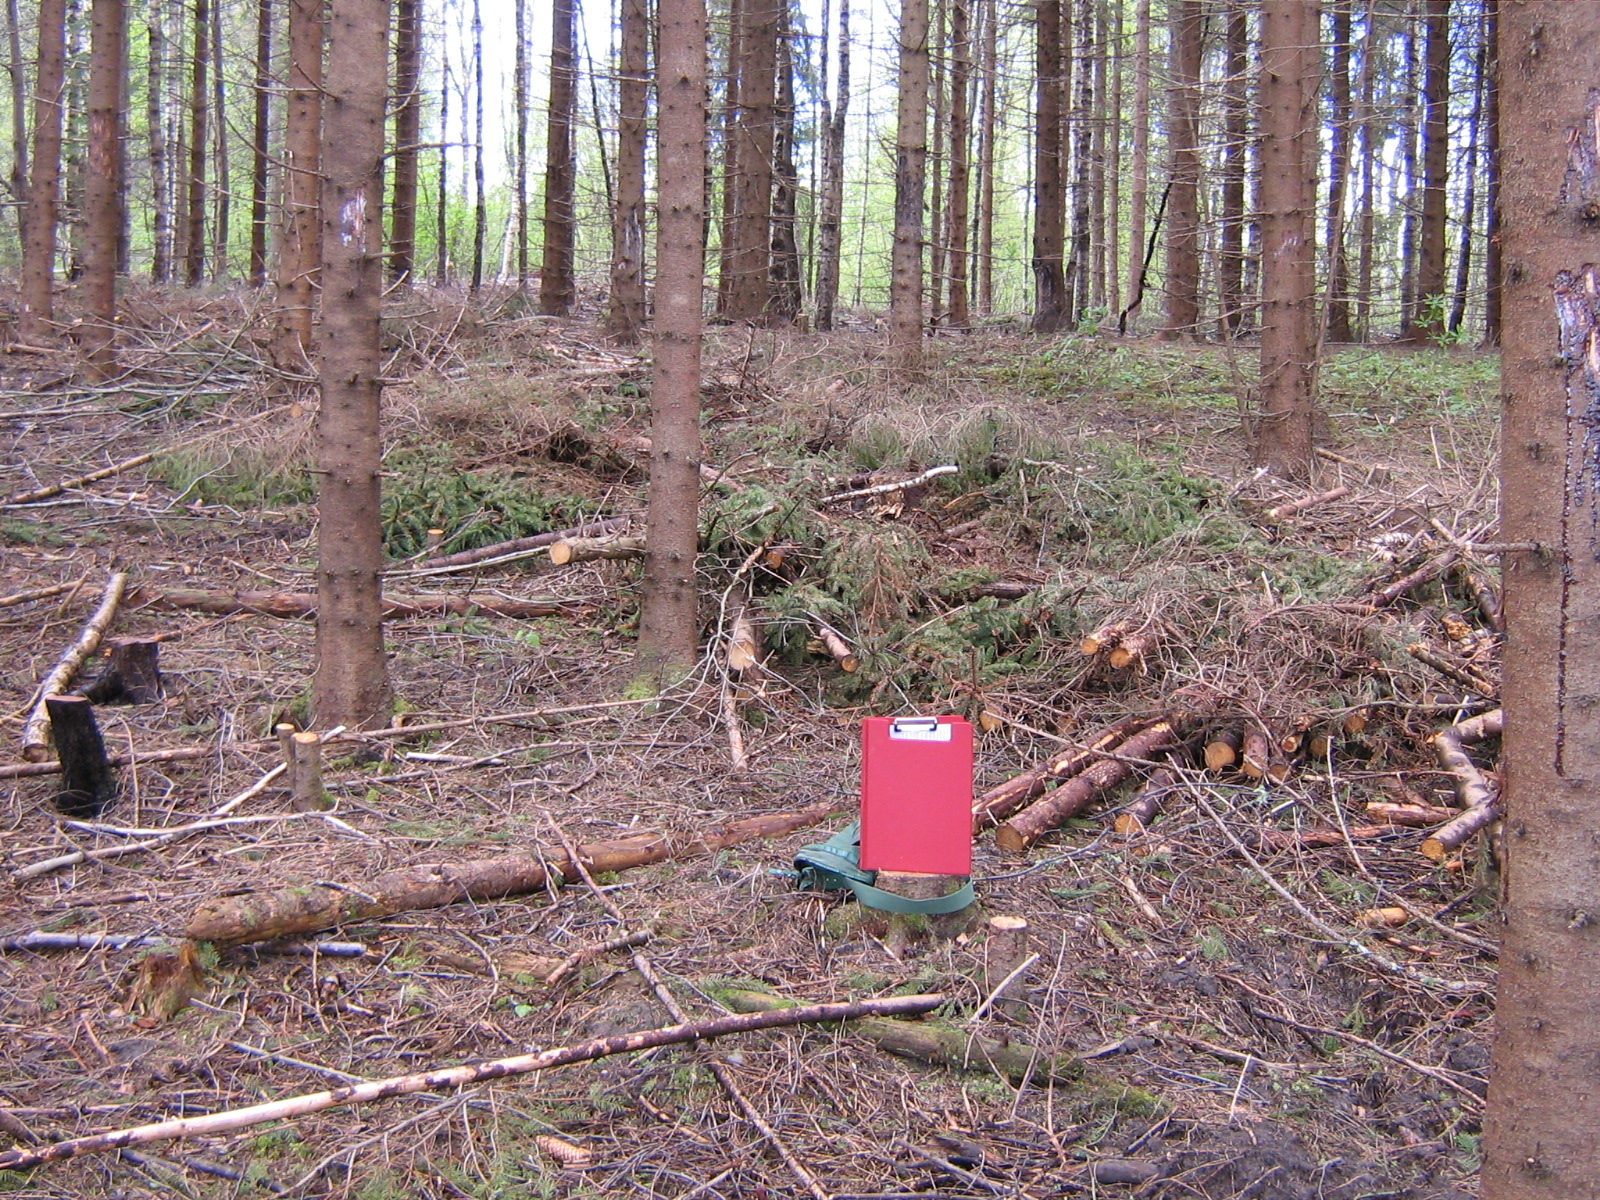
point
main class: Woodland
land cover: Spruce dominated mixed woodland
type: hemiboreal forest and nemoral coniferous forest and mixed broadleaved-coniferous forest
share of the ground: > 75 %
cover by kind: coniferous forest trees 70 %, broadleaved forest trees 30 %
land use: Forestry
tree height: > 5 m
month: May
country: LV
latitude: 57.1811
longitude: 25.5190
